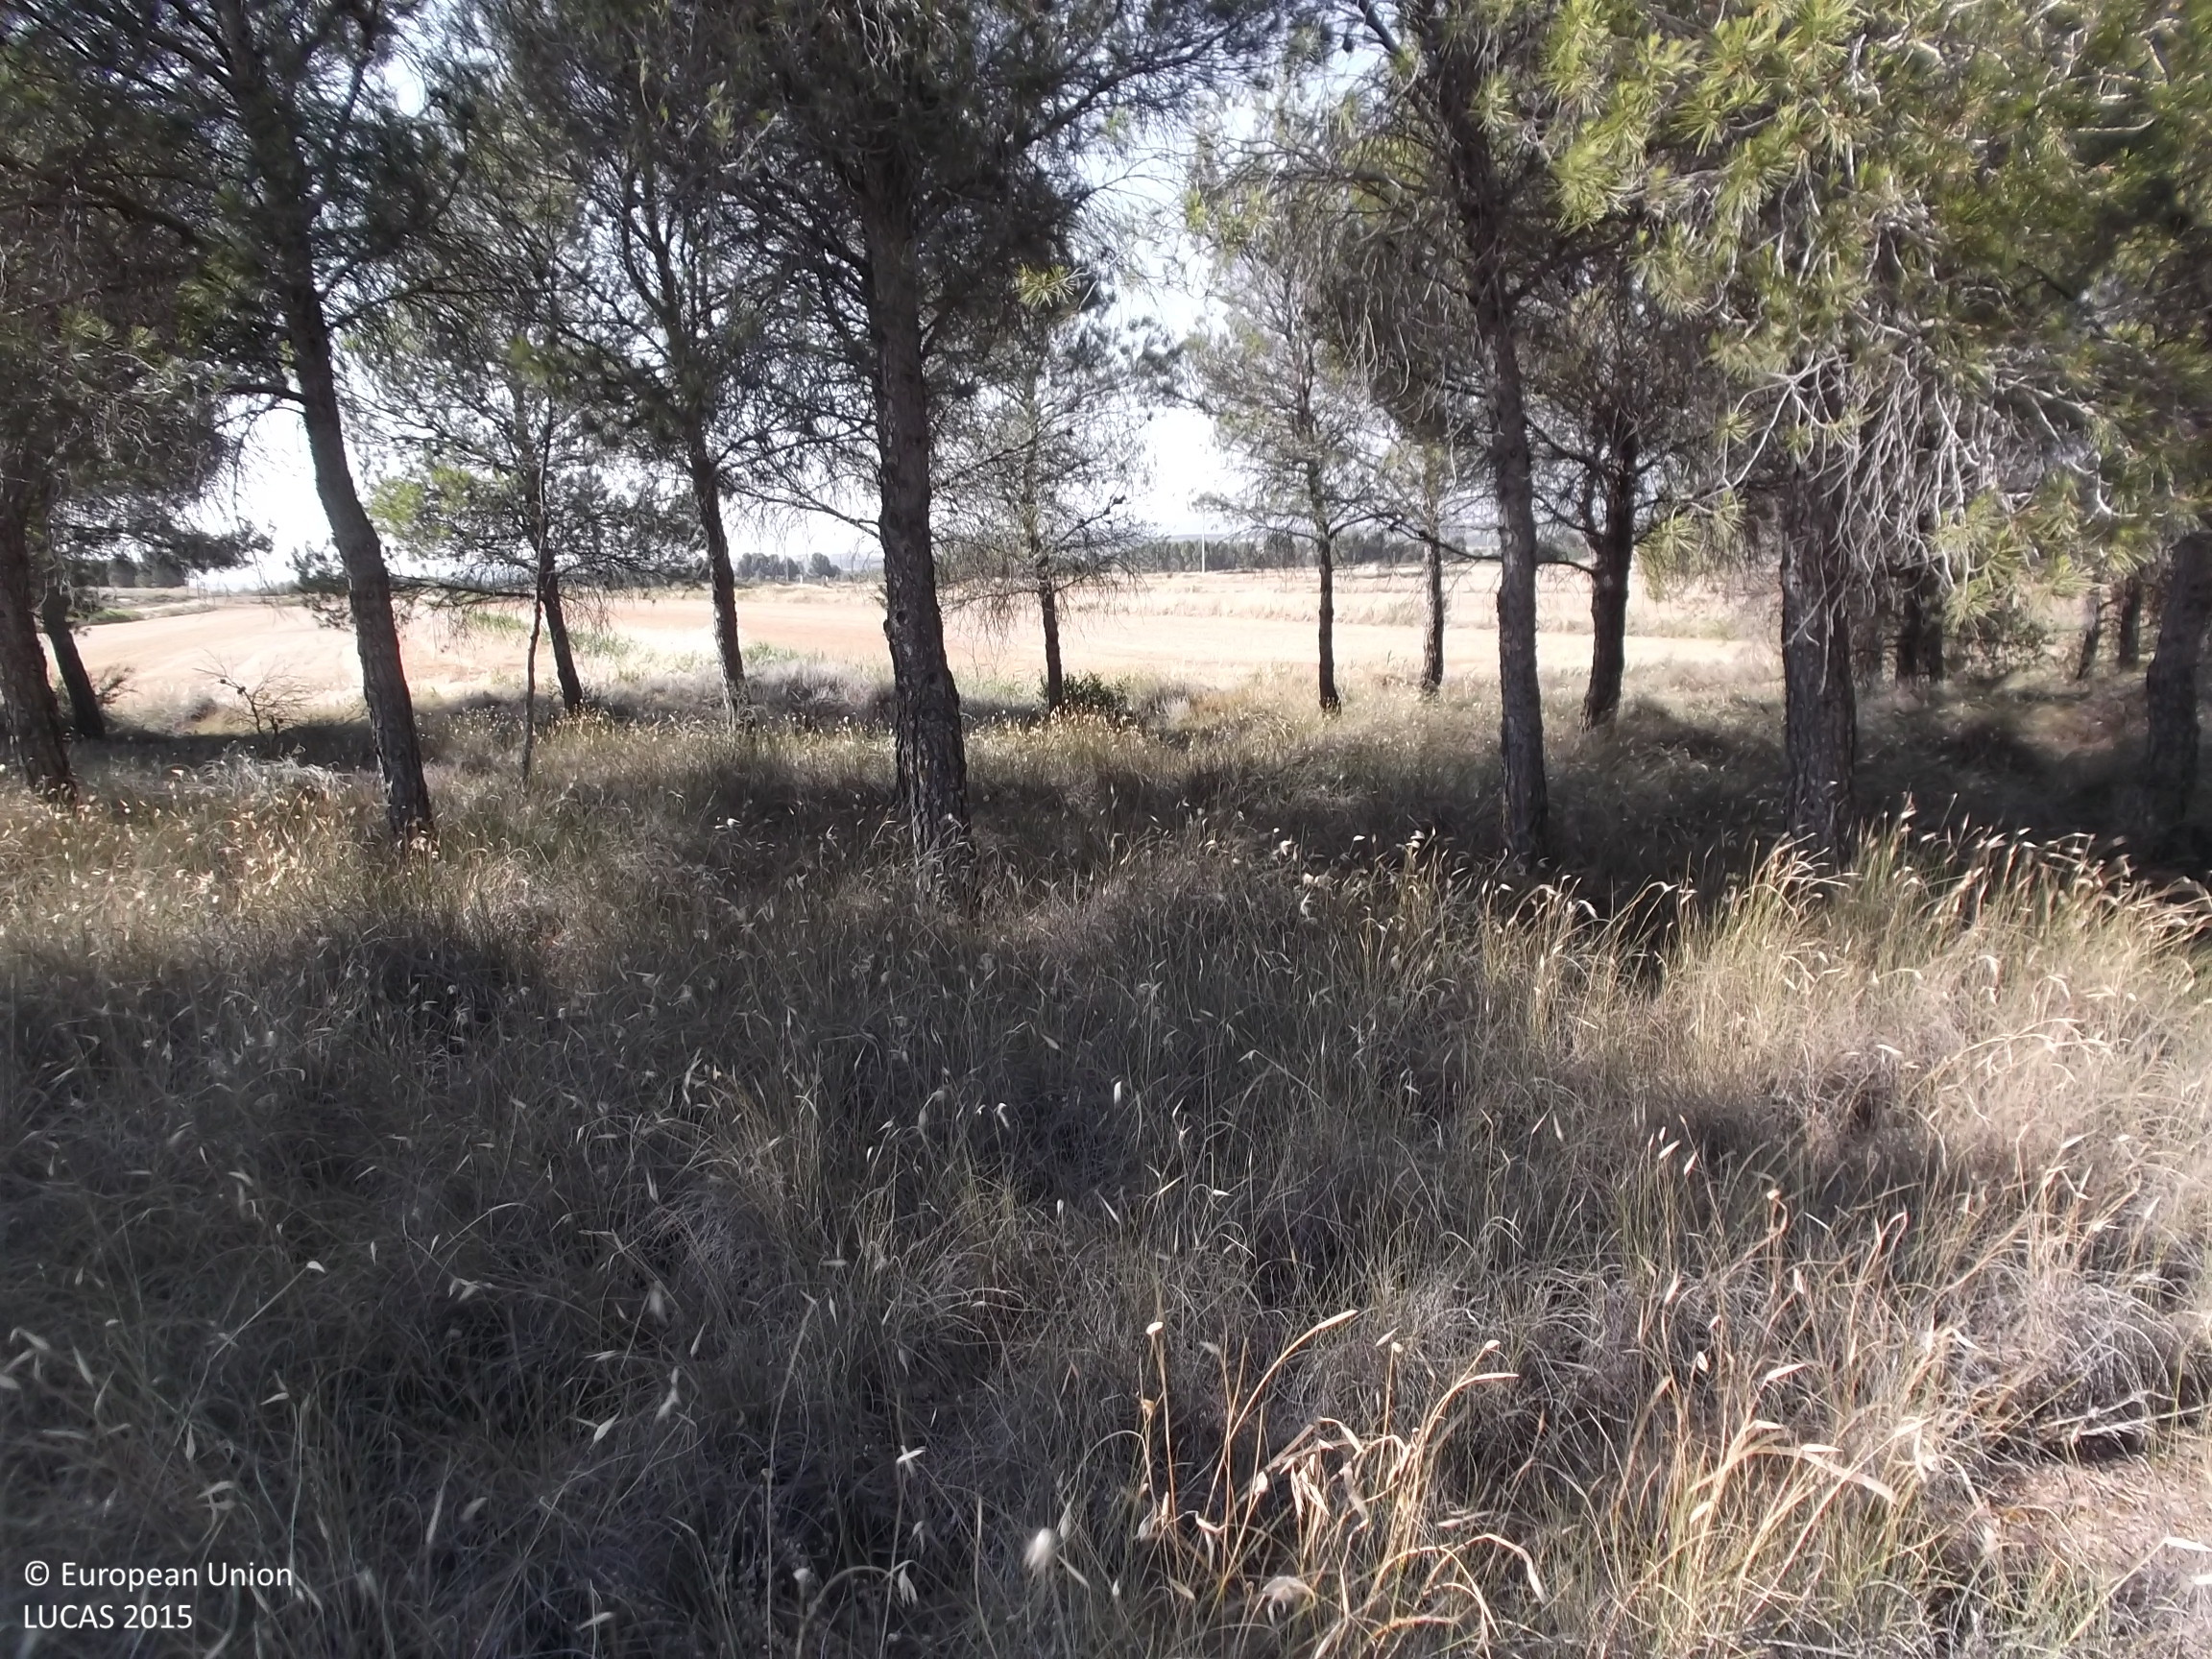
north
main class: Woodland
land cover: Pine dominated coniferous woodland
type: coniferous forest of the mediterranean region
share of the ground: 50 - 75 %
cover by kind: coniferous forest trees 70 %, herbaceous plants 20 %, unconsolidated bare surface 10 %
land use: Semi-natural and natural areas not in use
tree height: < 5 m
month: July
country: ES
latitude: 42.3315
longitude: -1.5999
